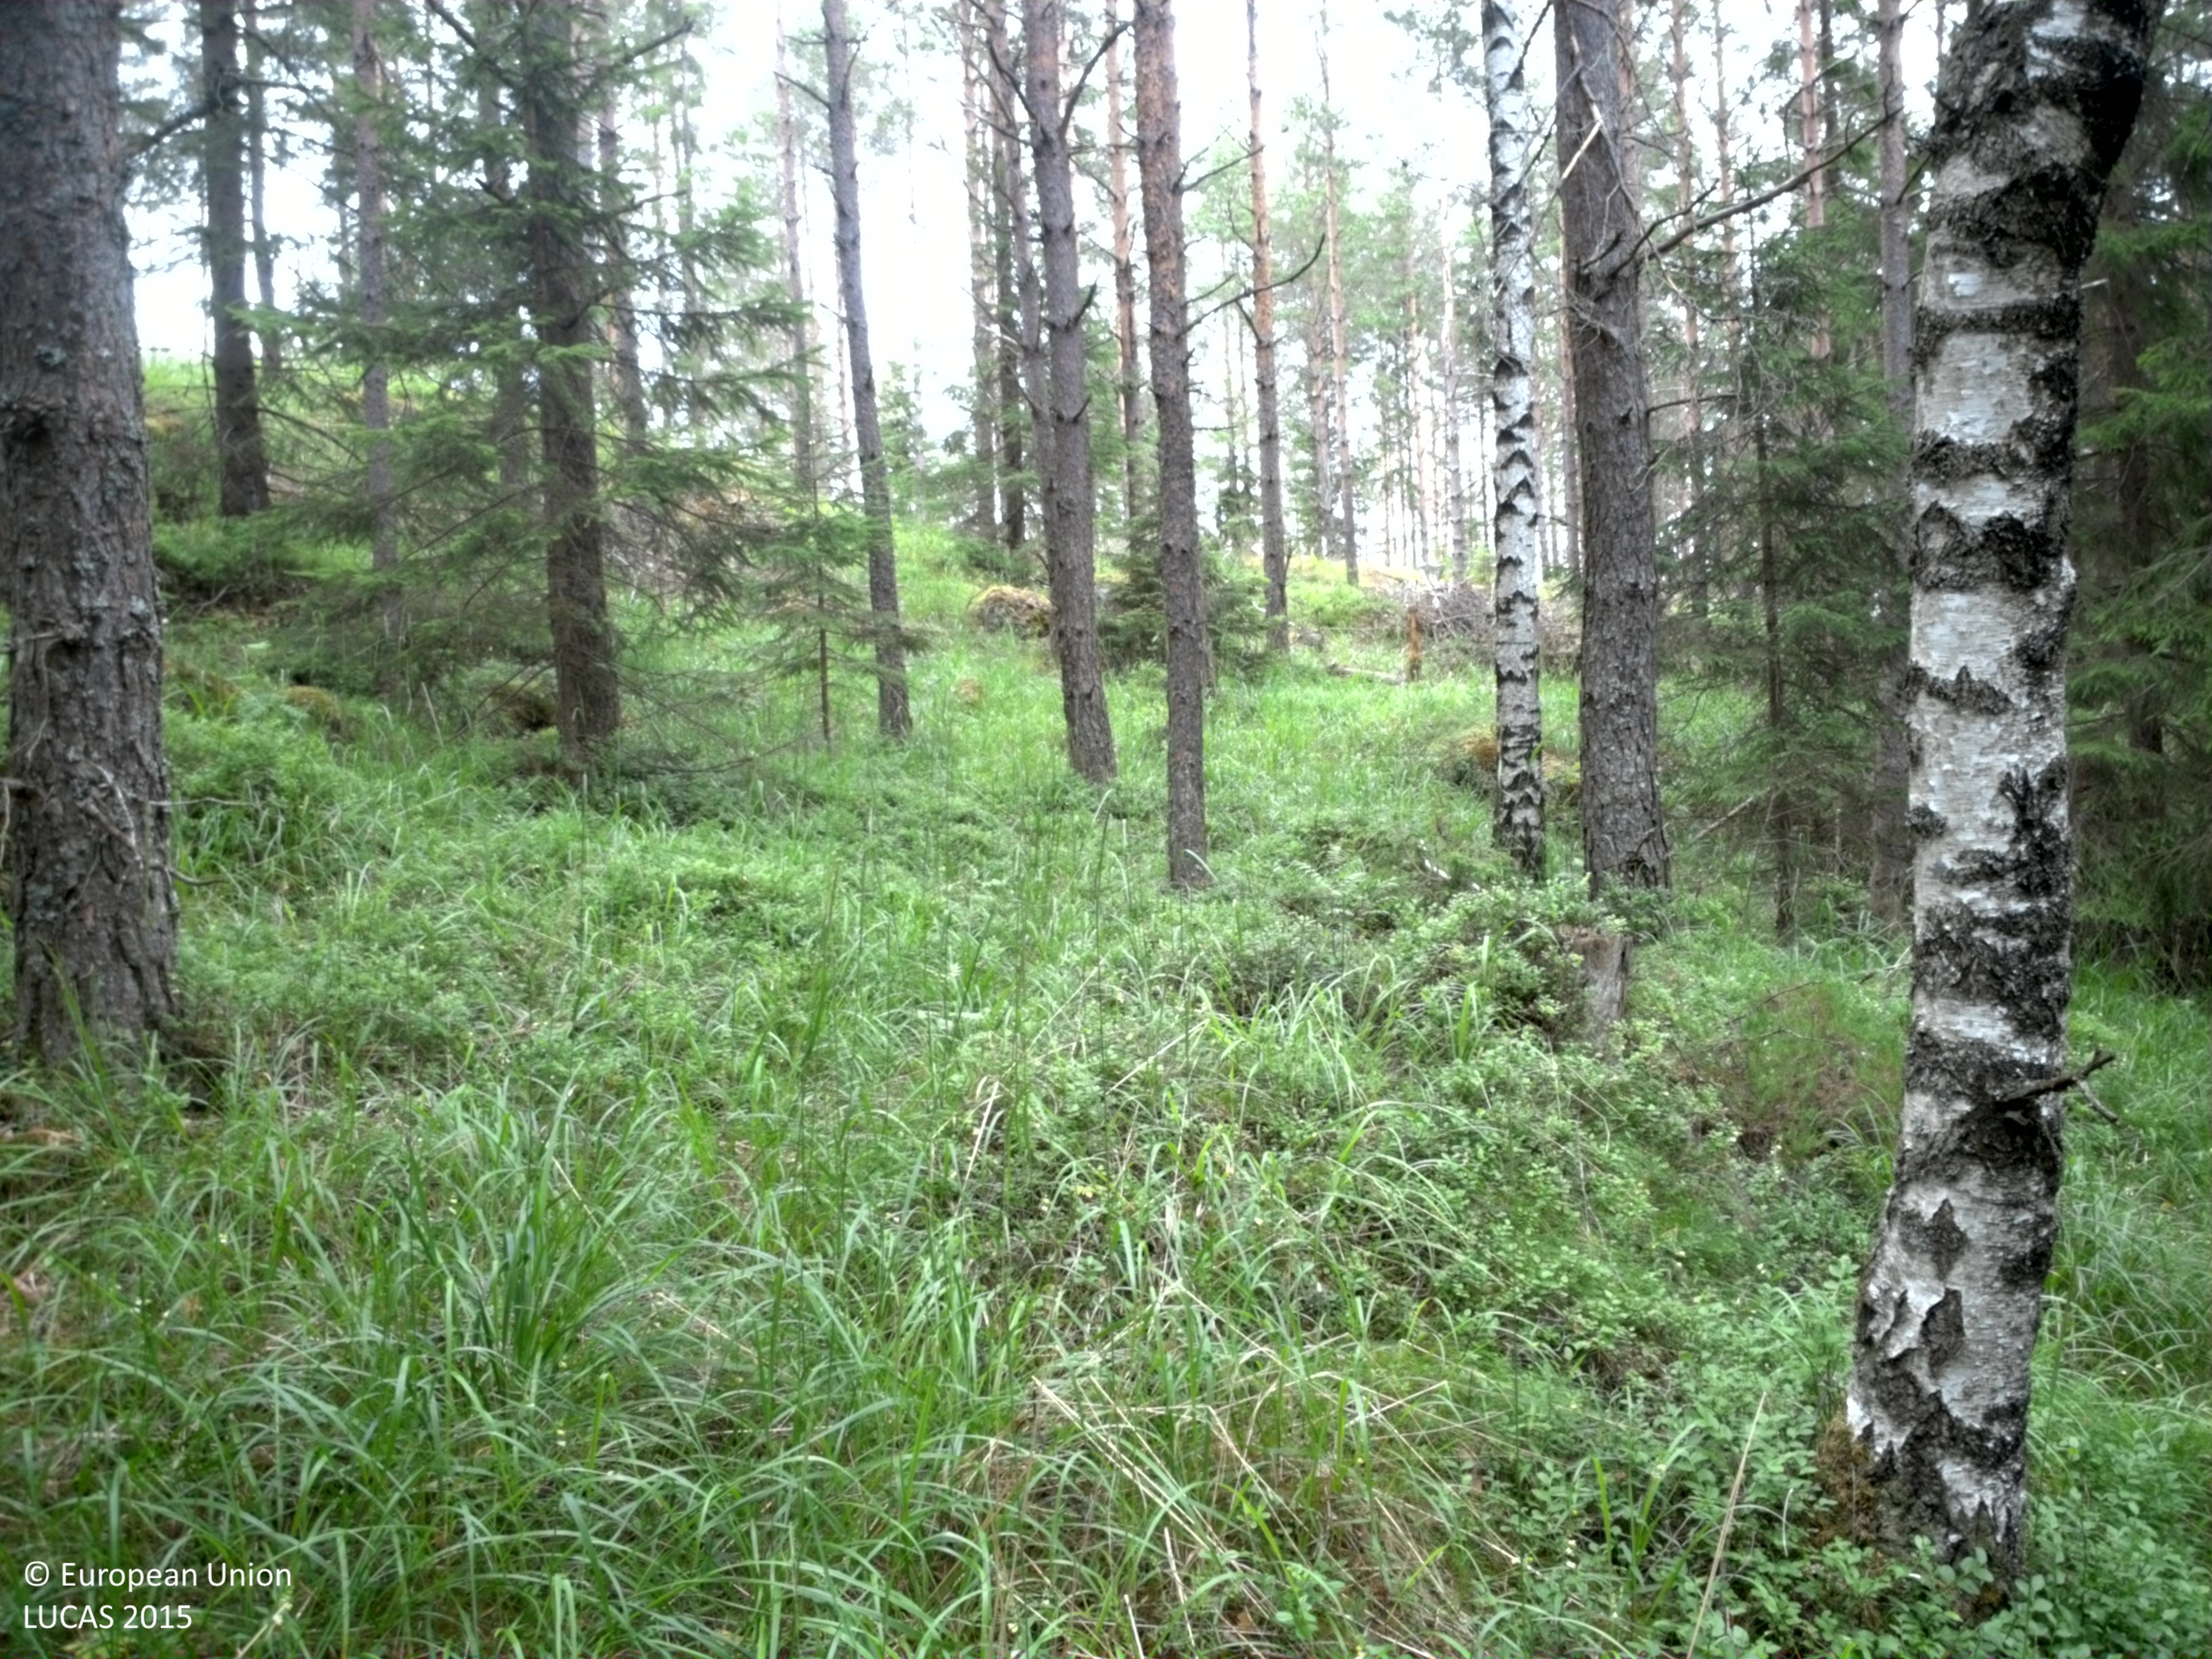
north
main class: Woodland
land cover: Spruce dominated mixed woodland
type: boreal forest
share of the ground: 25 - 50 %
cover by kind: coniferous forest trees 35 %, herbaceous plants 25 %, broadleaved forest trees 15 %, shrubs 15 %, lichens and mosses 10 %
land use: Forestry
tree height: > 5 m
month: July
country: SE
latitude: 59.6093
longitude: 11.9264
